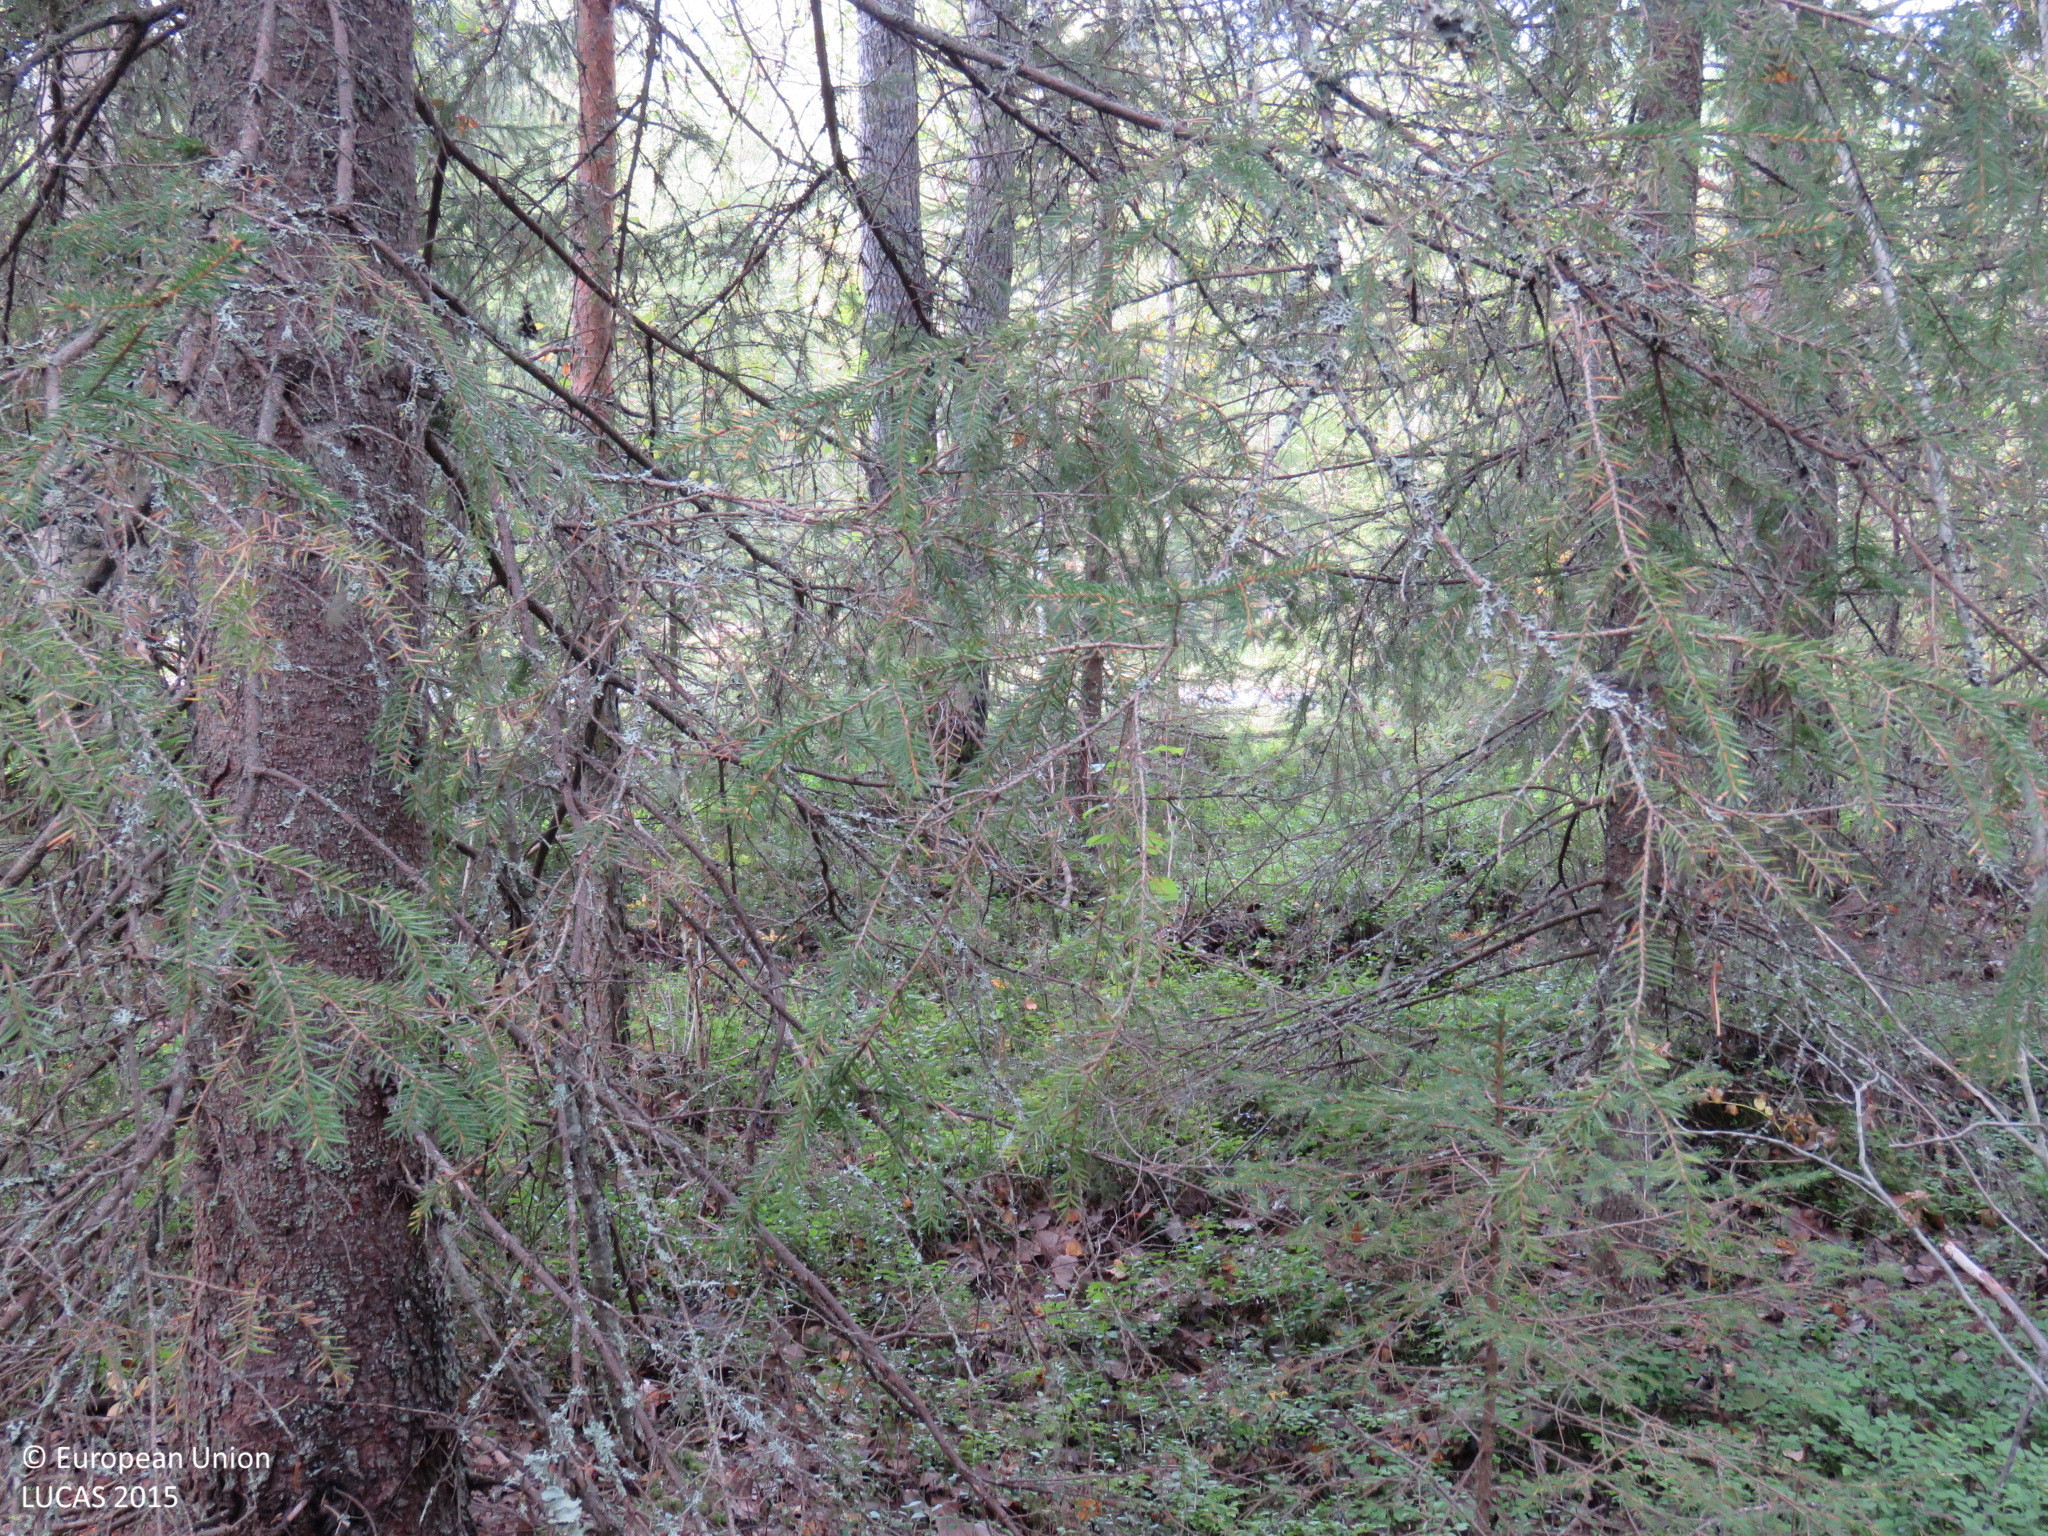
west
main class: Woodland
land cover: Other mixed woodland
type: boreal forest
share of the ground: > 75 %
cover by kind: coniferous forest trees 50 %, broadleaved forest trees 40 %, shrubs 10 %
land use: Forestry
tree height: > 5 m
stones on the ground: < 10 %
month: August
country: FI
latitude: 64.9549
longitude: 26.1255
